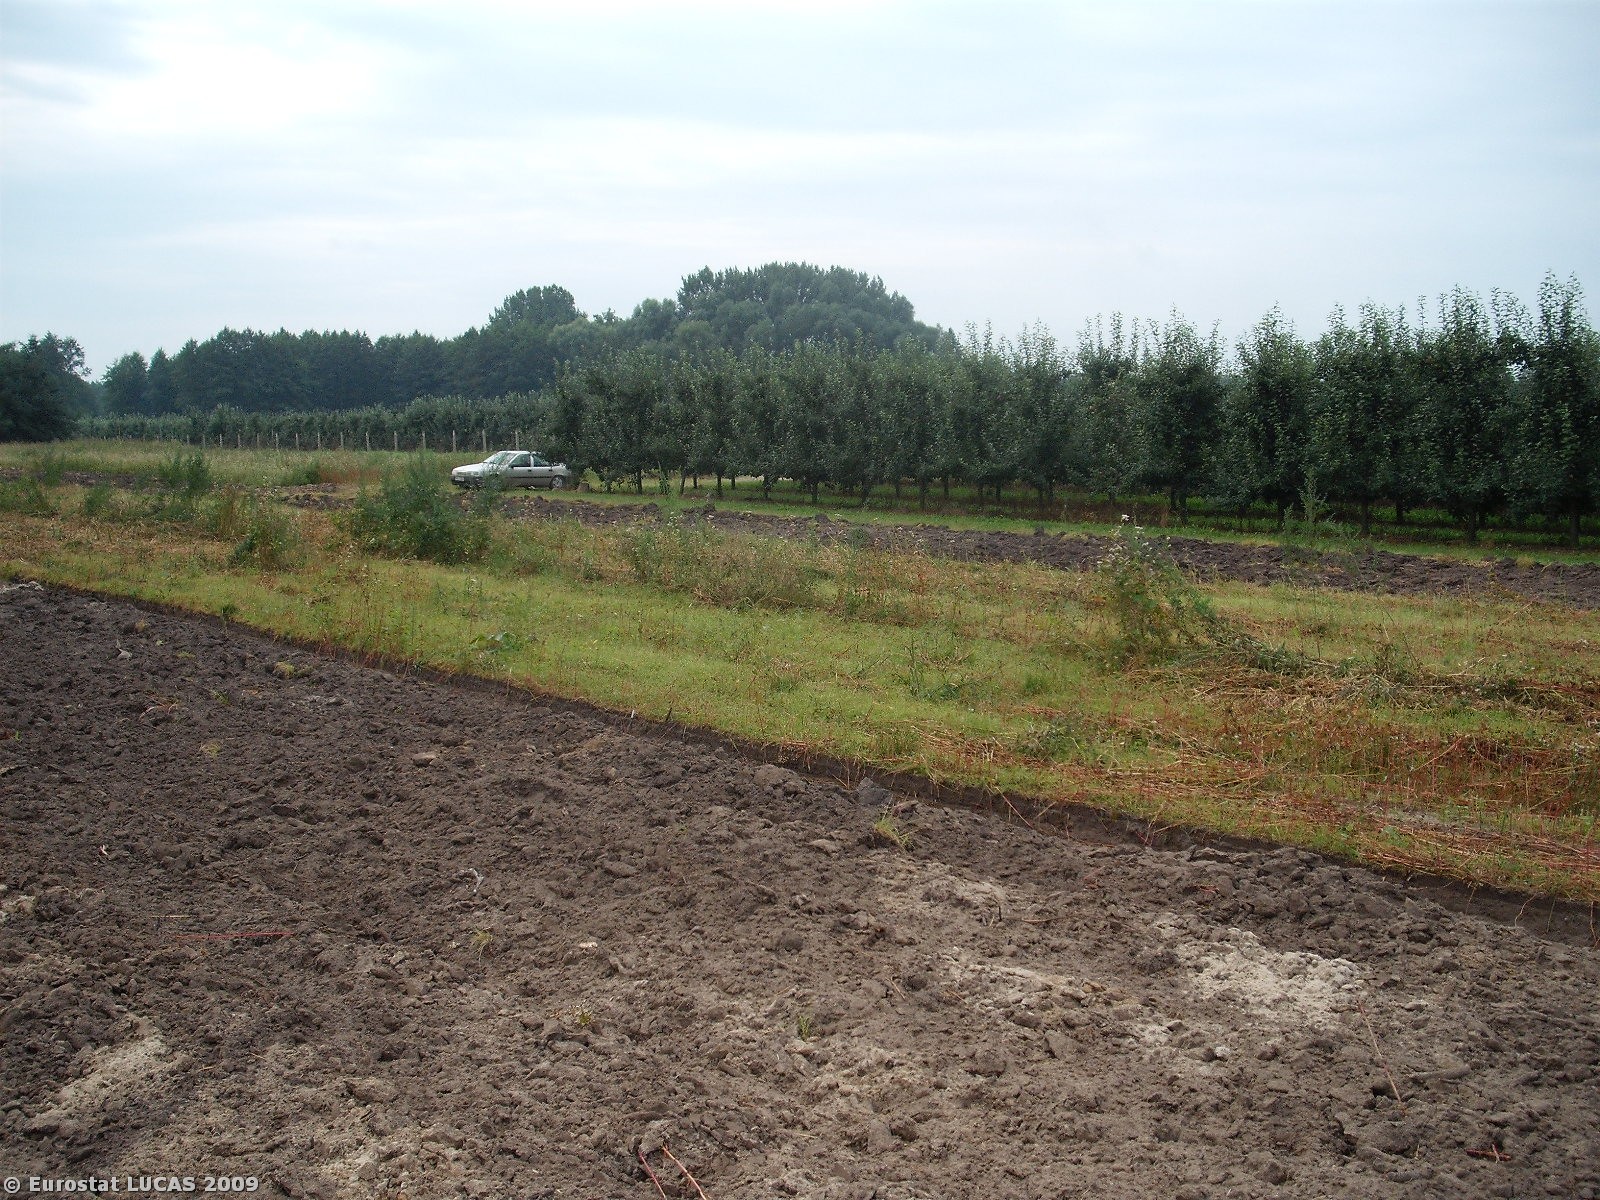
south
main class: Cropland
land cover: Apple fruit
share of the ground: 50 - 75 %
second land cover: Grassland with sparse tree/shrub cover
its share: > 75 %
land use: Agriculture (excluding fallow land and kitchen gardens)
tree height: < 5 m
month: August
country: PL
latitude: 51.7615
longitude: 21.1301
